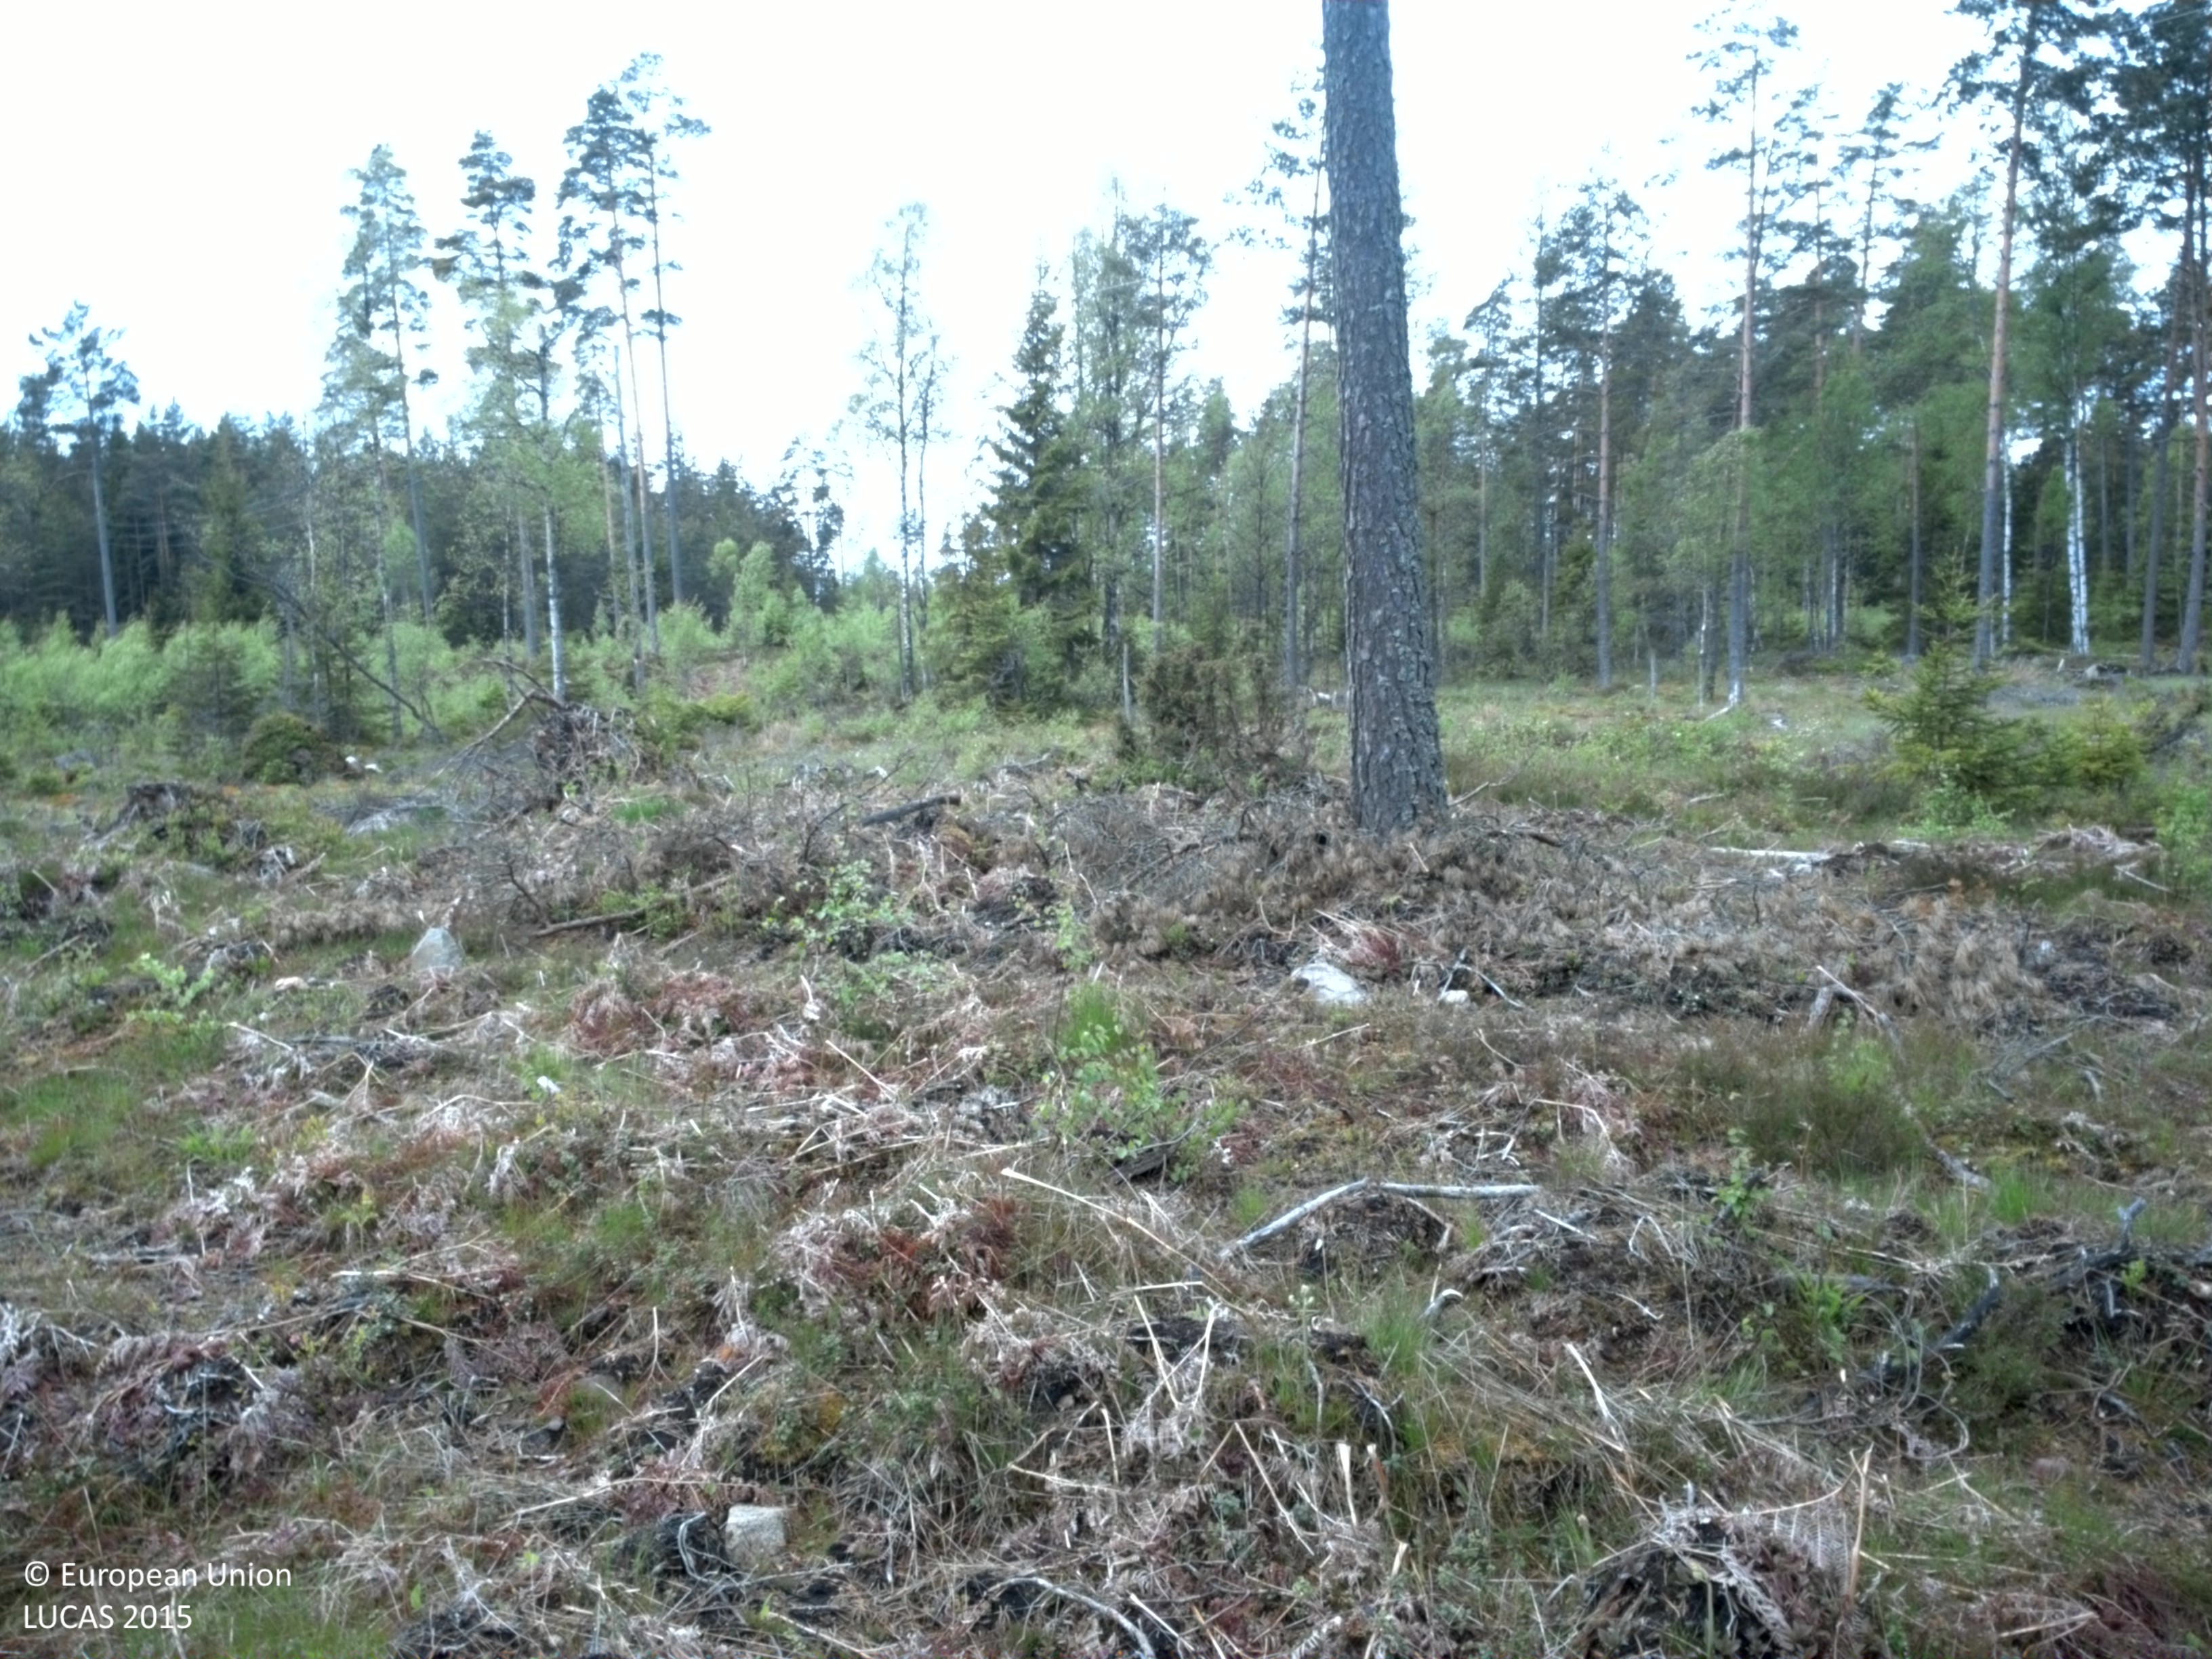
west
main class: Woodland
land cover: Pine dominated coniferous woodland
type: boreal forest
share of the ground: 10 - 25 %
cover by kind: herbaceous plants 35 %, shrubs 25 %, coniferous forest trees 20 %, lichens and mosses 15 %, broadleaved forest trees 5 %
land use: Forestry
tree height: > 5 m
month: May
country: SE
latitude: 56.8261
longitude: 15.5205
